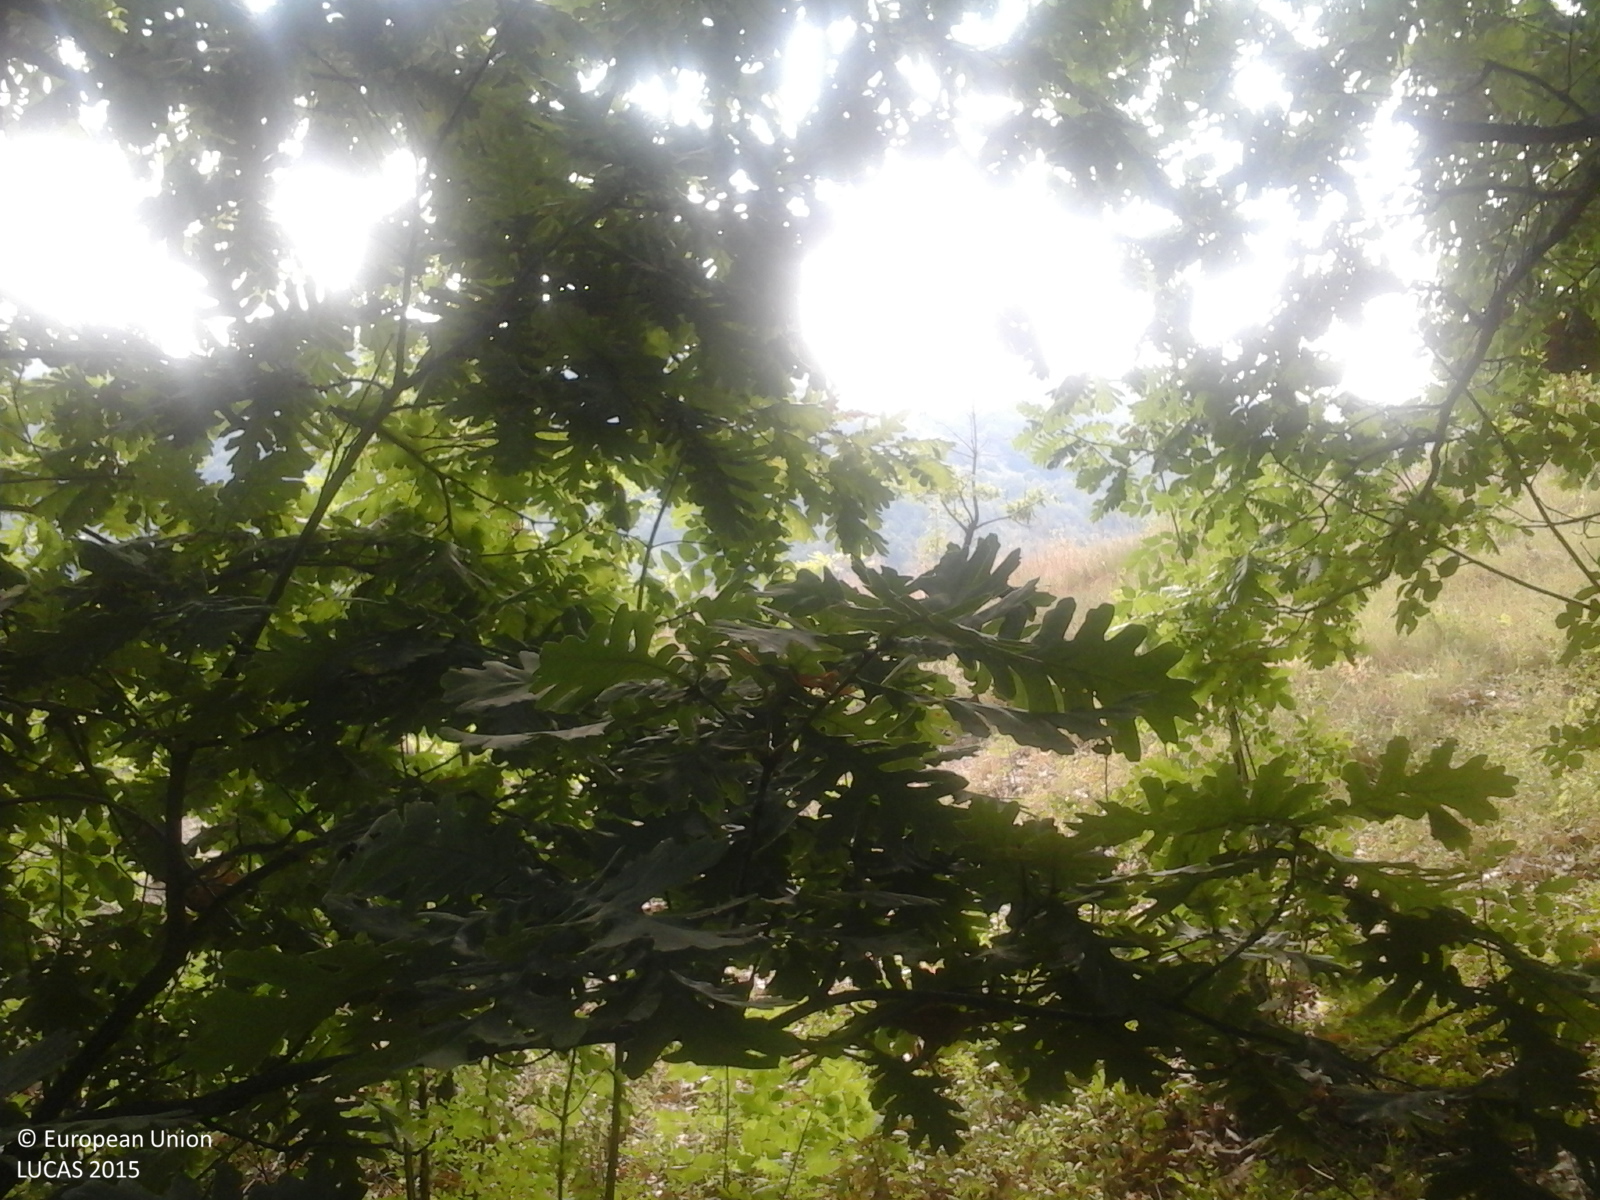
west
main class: Woodland
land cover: Broadleaved woodland
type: acidophilous oak and oak-birch forest
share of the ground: > 75 %
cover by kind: broadleaved forest trees 100 %
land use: Forestry
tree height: > 5 m
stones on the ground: < 10 %
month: August
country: RO
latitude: 44.7815
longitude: 23.6181
